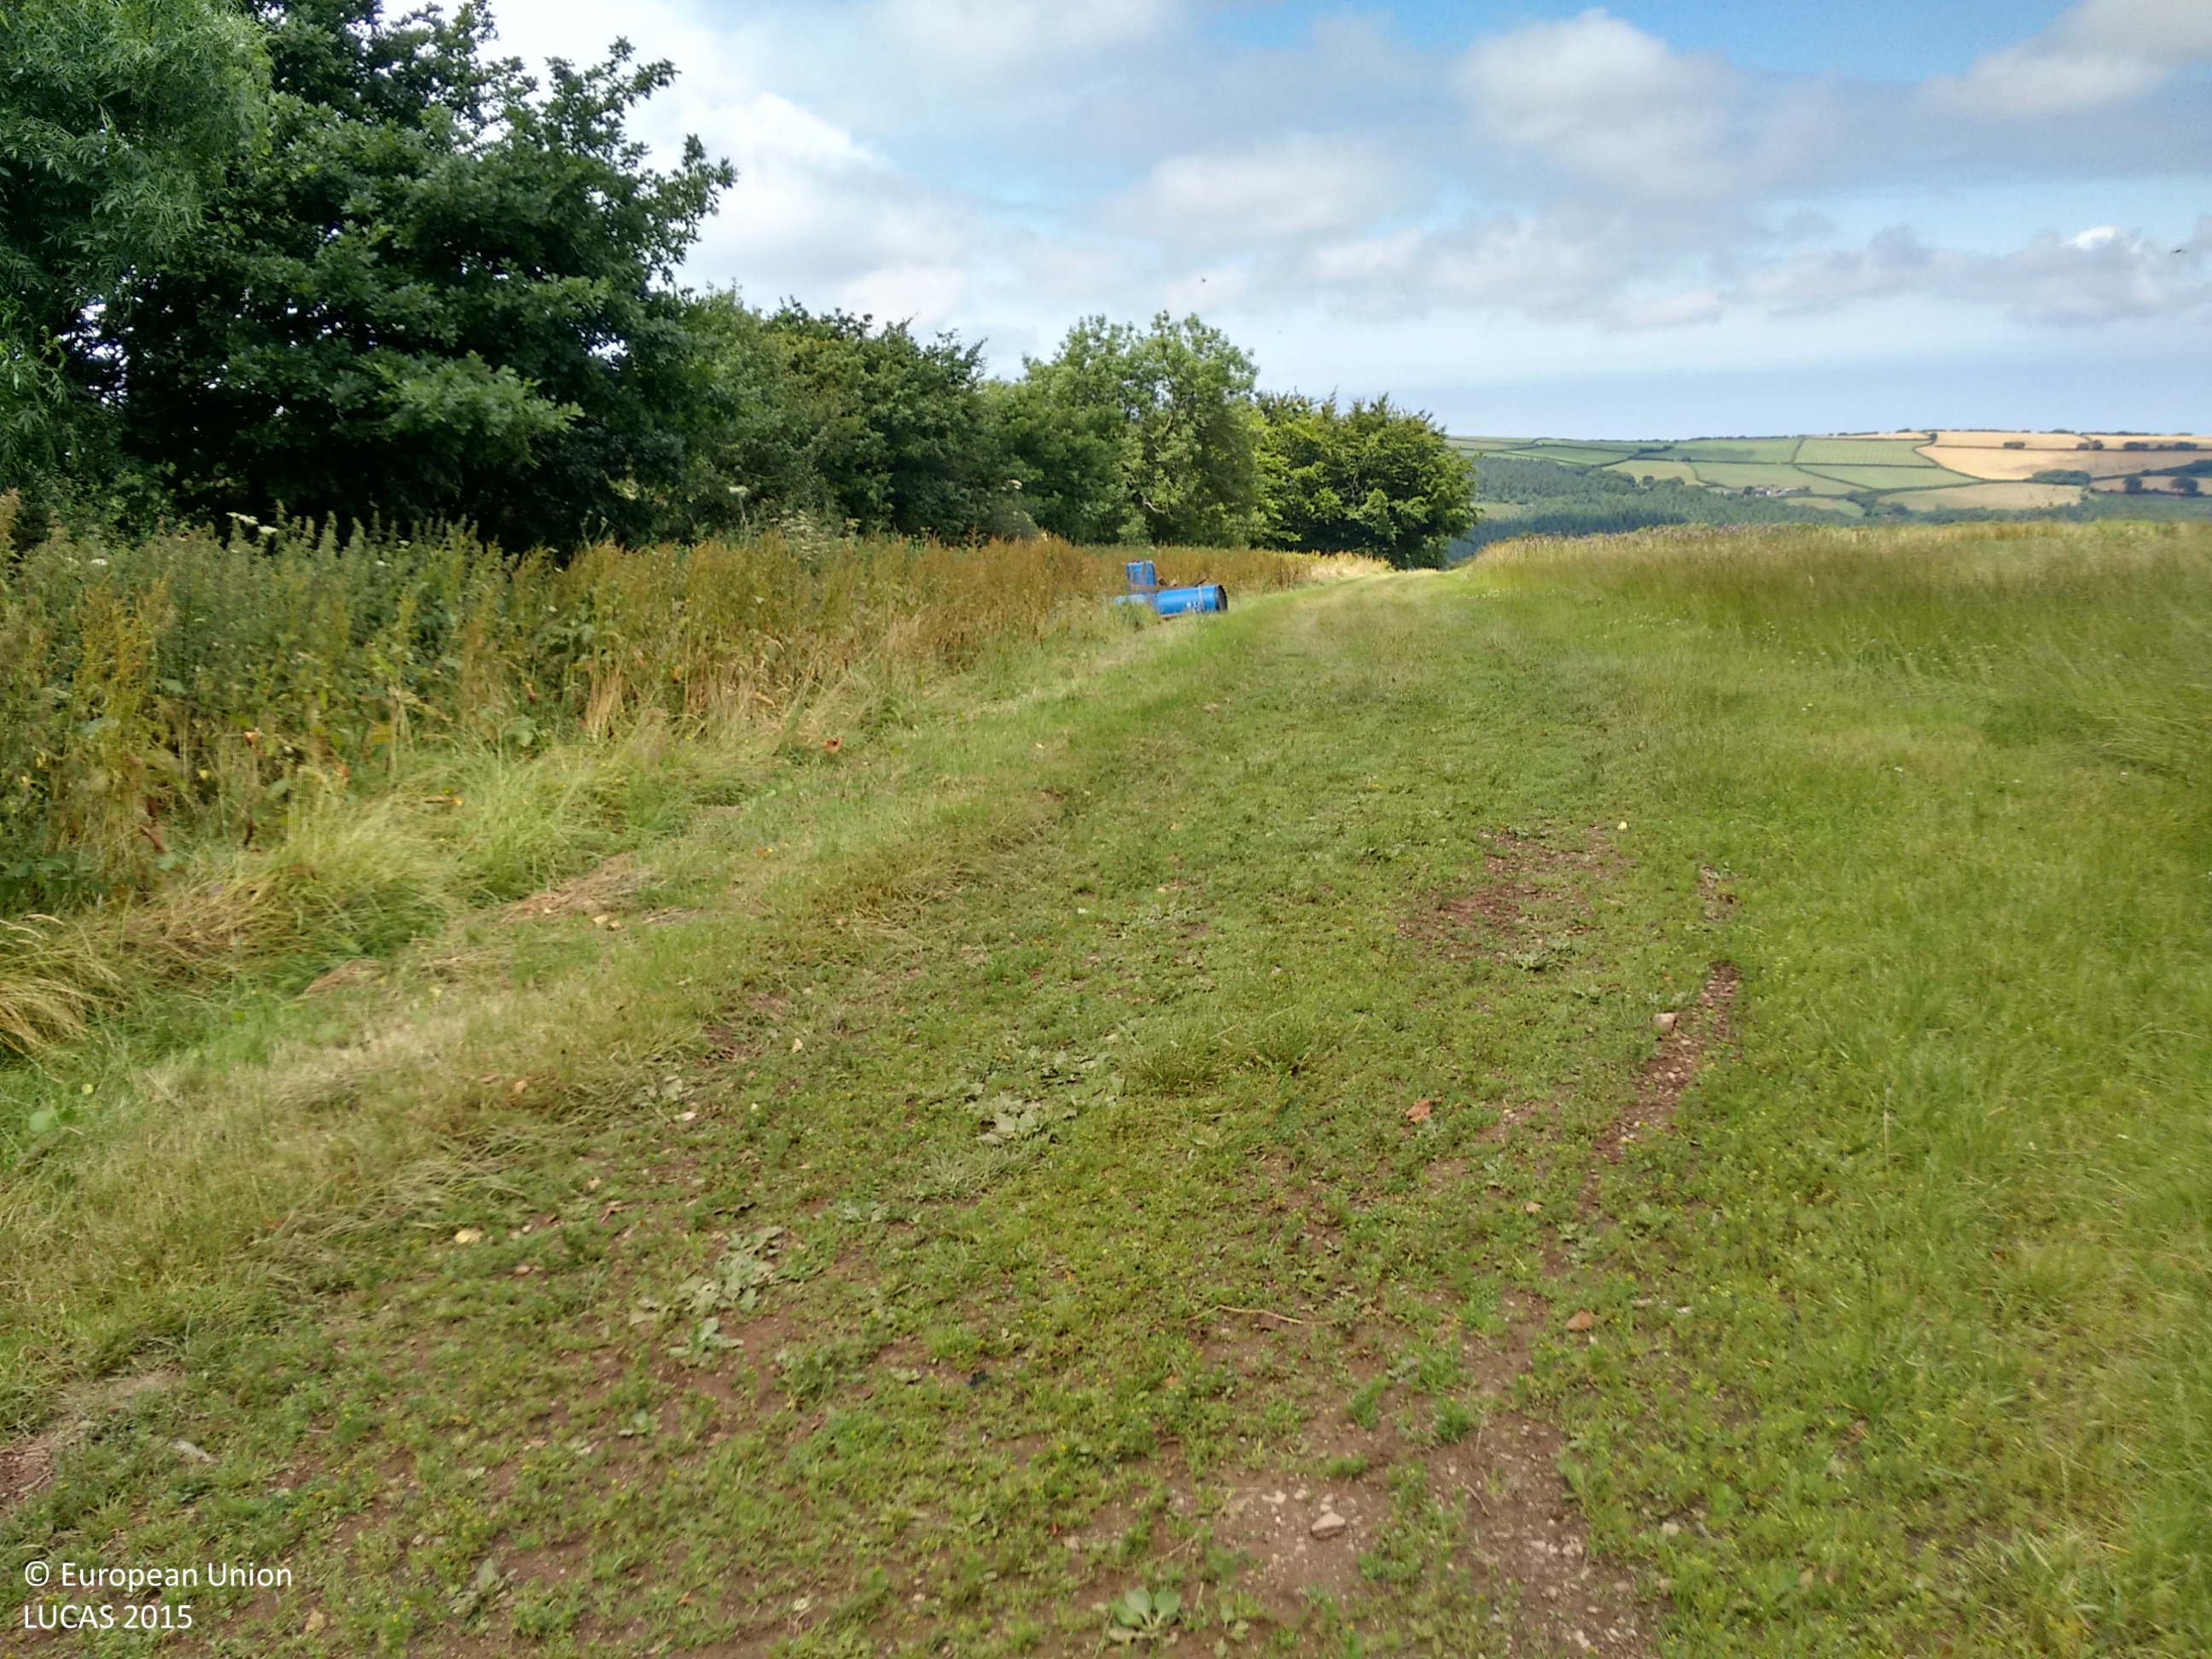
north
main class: Grassland
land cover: Spontaneously vegetated surfaces
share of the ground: > 75 %
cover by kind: herbaceous plants 75 %, unconsolidated bare surface 25 %
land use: Agriculture (excluding fallow land and kitchen gardens)
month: July
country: GB
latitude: 51.1162
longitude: -3.4401
